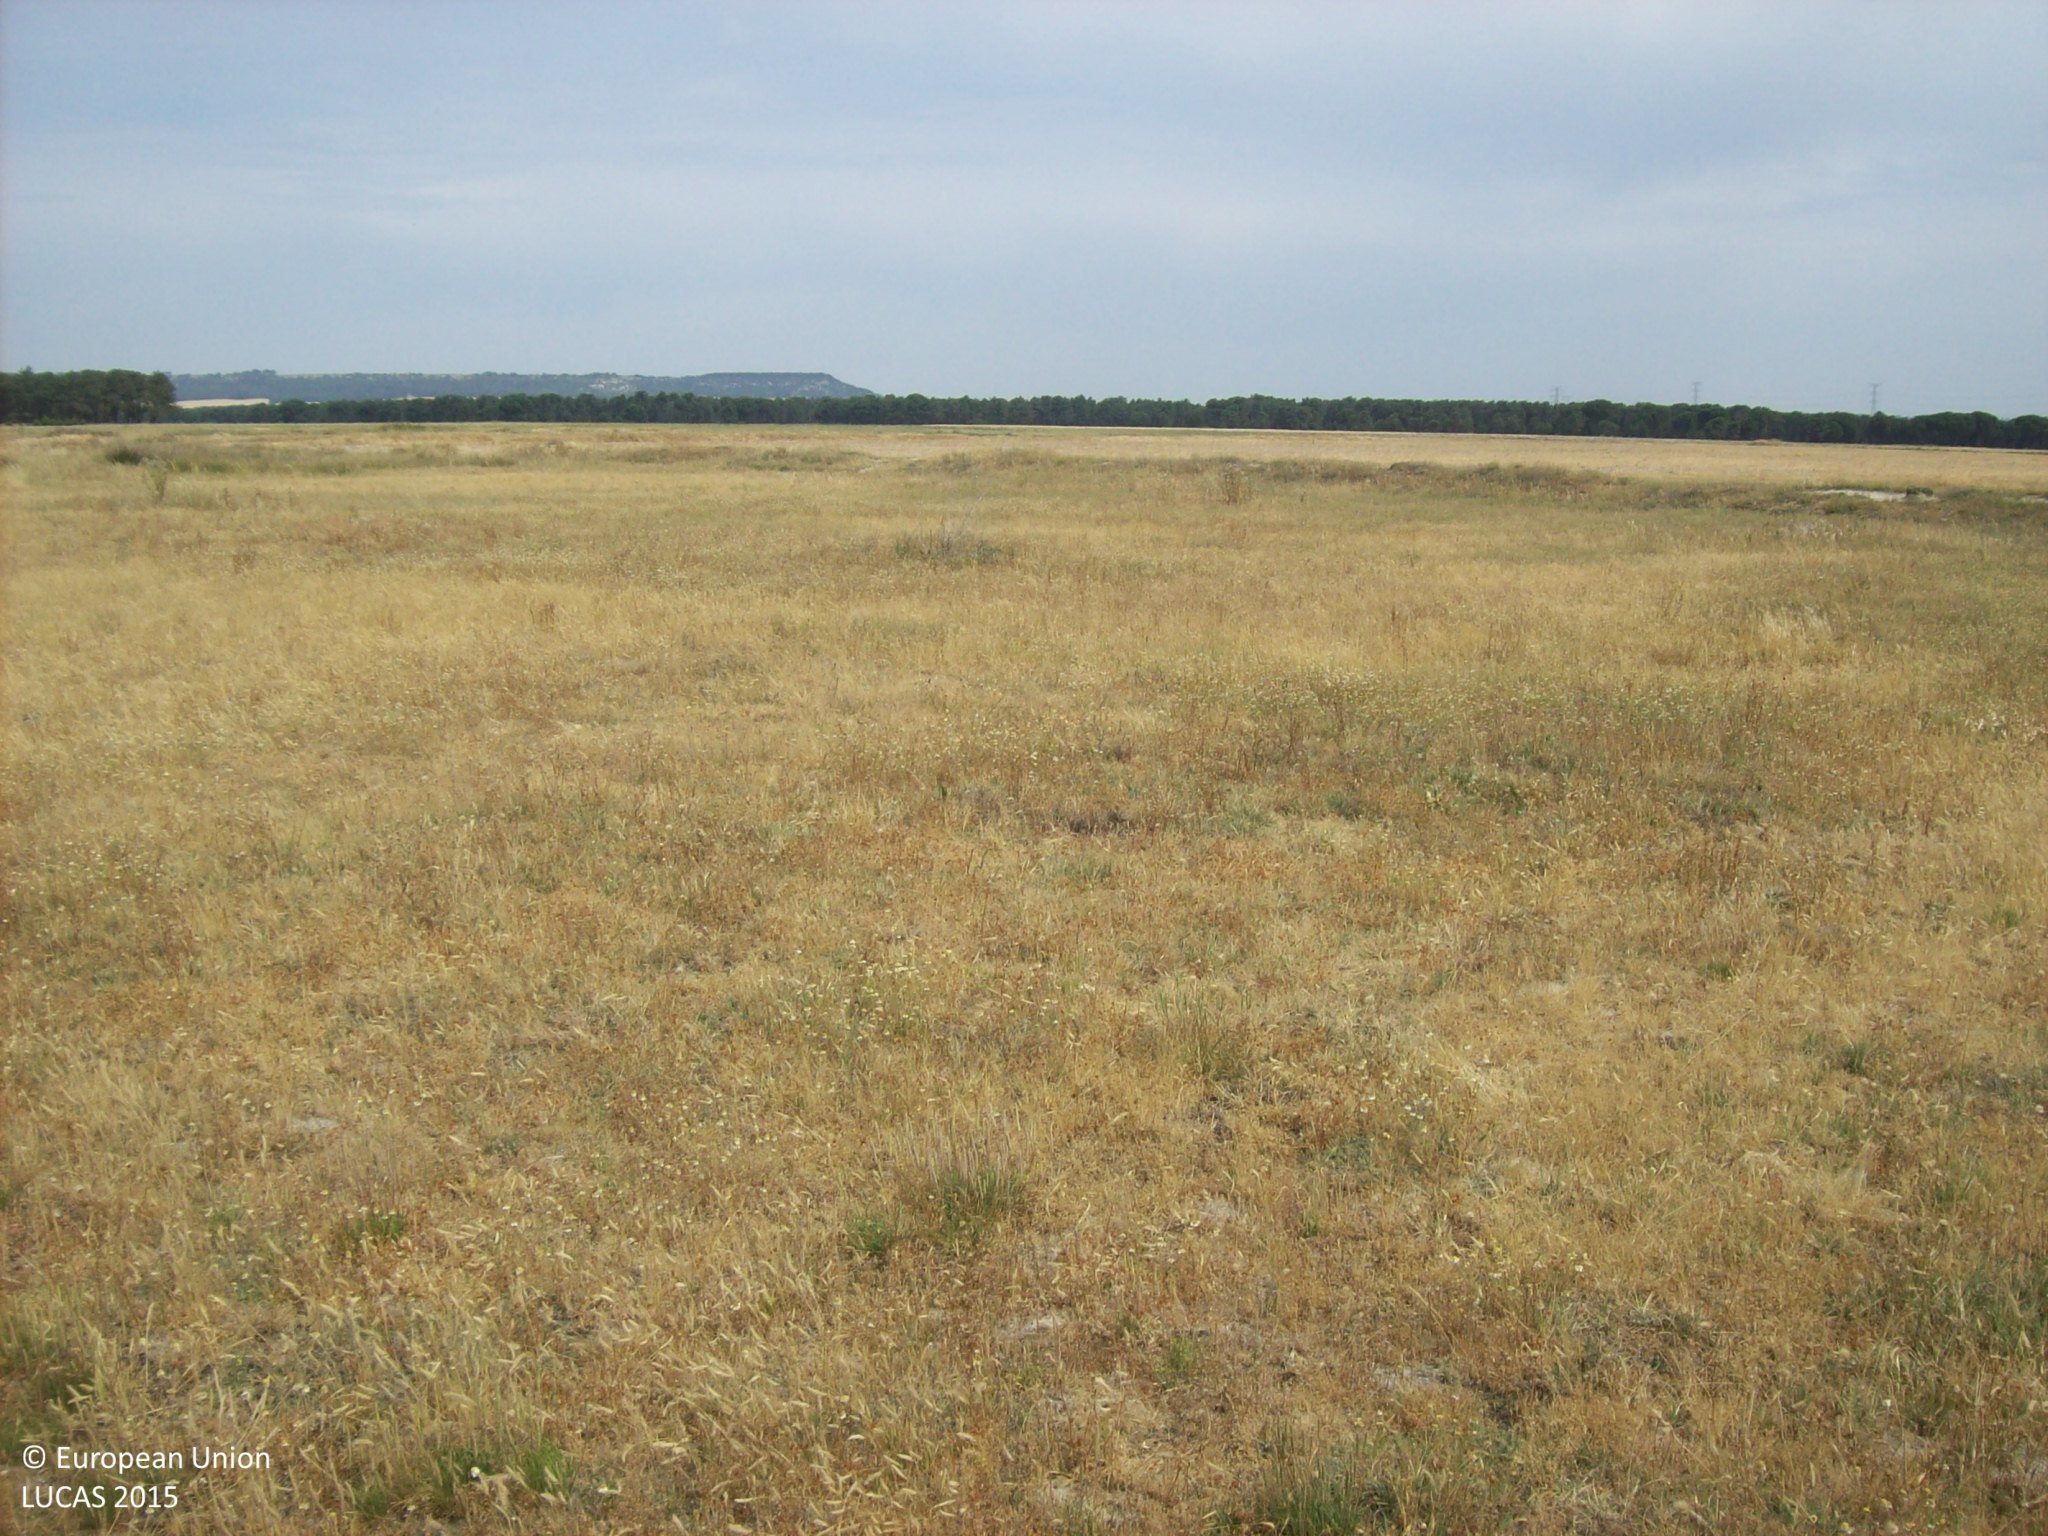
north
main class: Grassland
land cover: Grassland without tree/shrub cover
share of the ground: > 75 %
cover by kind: herbaceous plants 100 %
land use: Semi-natural and natural areas not in use
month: June
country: ES
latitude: 41.2758
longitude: -4.6153
